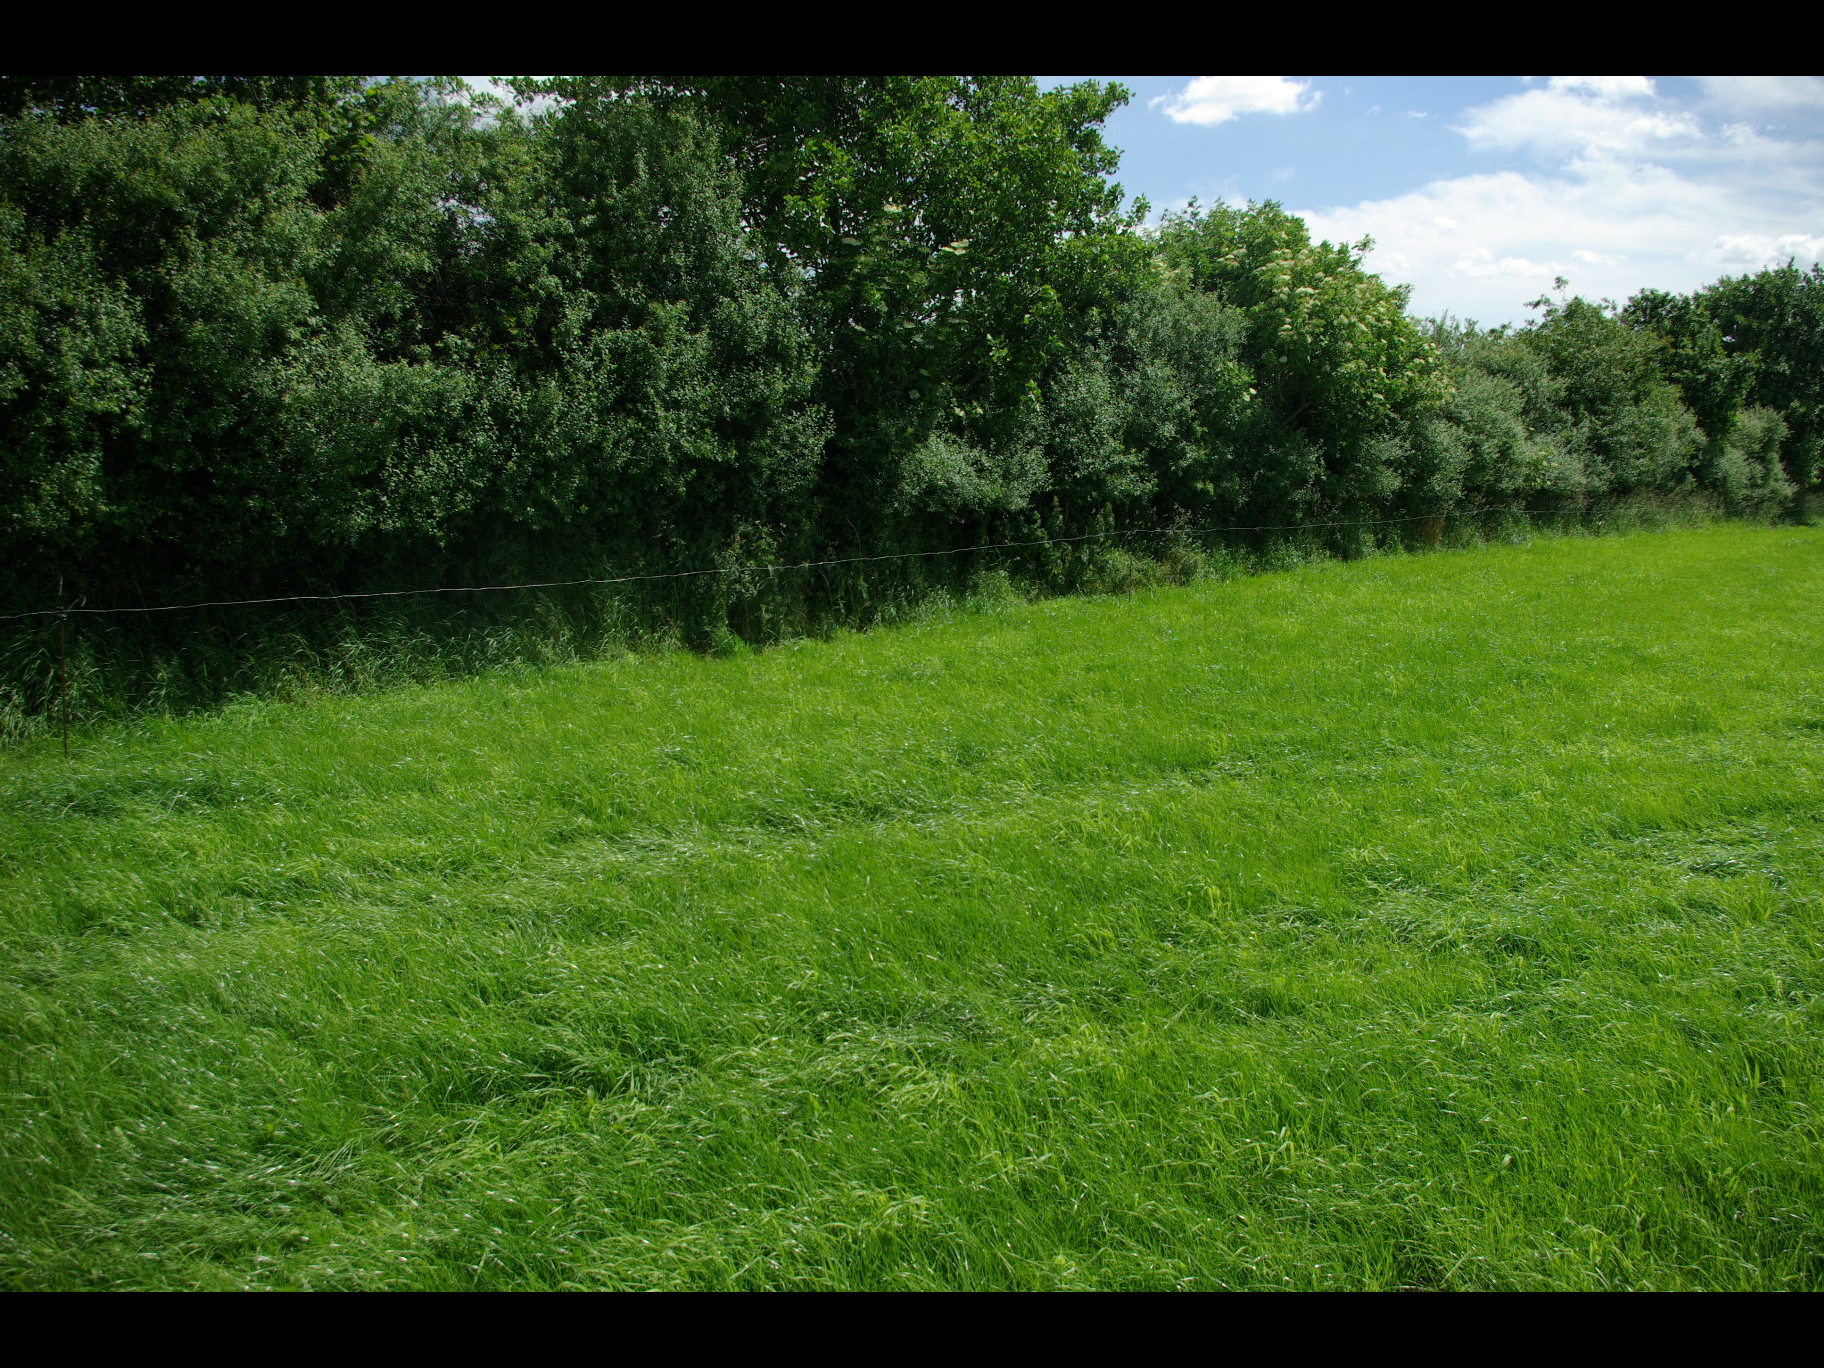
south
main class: Grassland
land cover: Grassland without tree/shrub cover
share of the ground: > 75 %
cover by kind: herbaceous plants 100 %
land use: Agriculture (excluding fallow land and kitchen gardens)
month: June
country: DE
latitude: 54.3899
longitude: 9.6460
